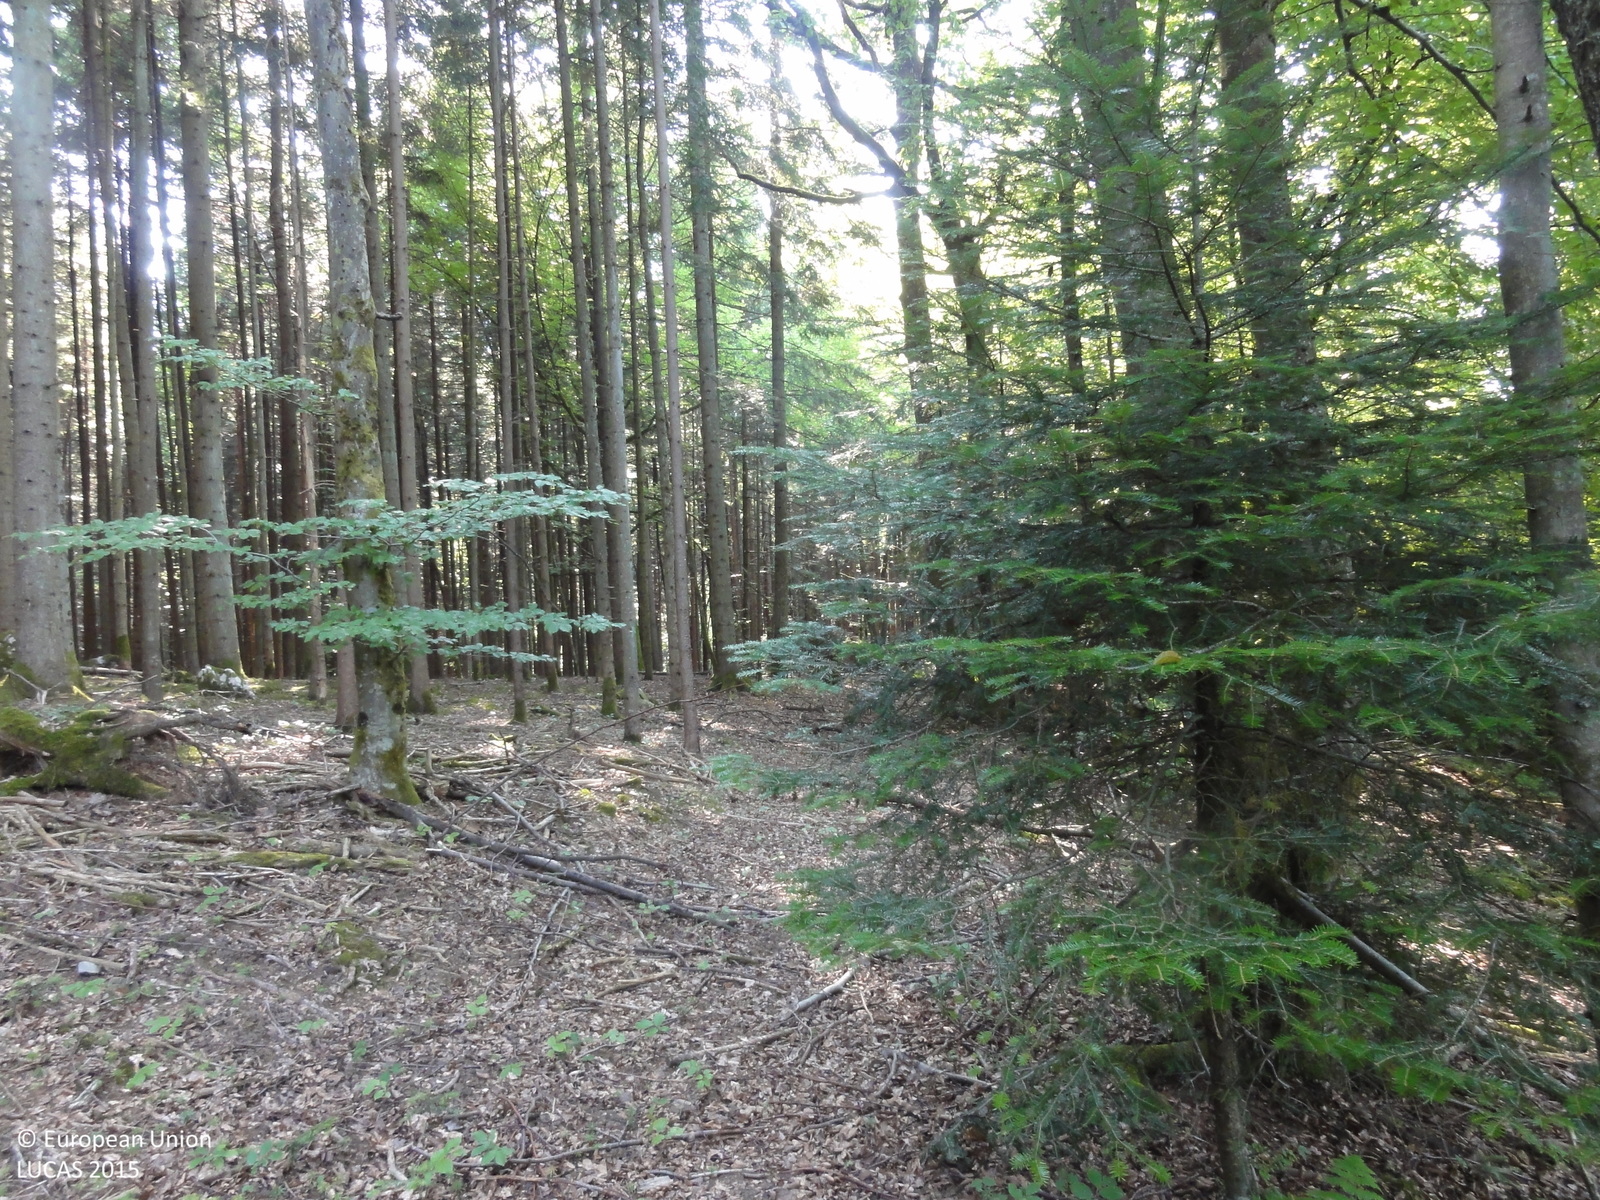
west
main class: Woodland
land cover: Spruce dominated mixed woodland
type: hemiboreal forest and nemoral coniferous forest and mixed broadleaved-coniferous forest
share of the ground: > 75 %
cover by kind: coniferous forest trees 40 %, broadleaved forest trees 40 %, shrubs 10 %, herbaceous plants 10 %
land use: Forestry
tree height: > 5 m
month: July
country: SI
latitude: 45.9173
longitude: 14.8314
